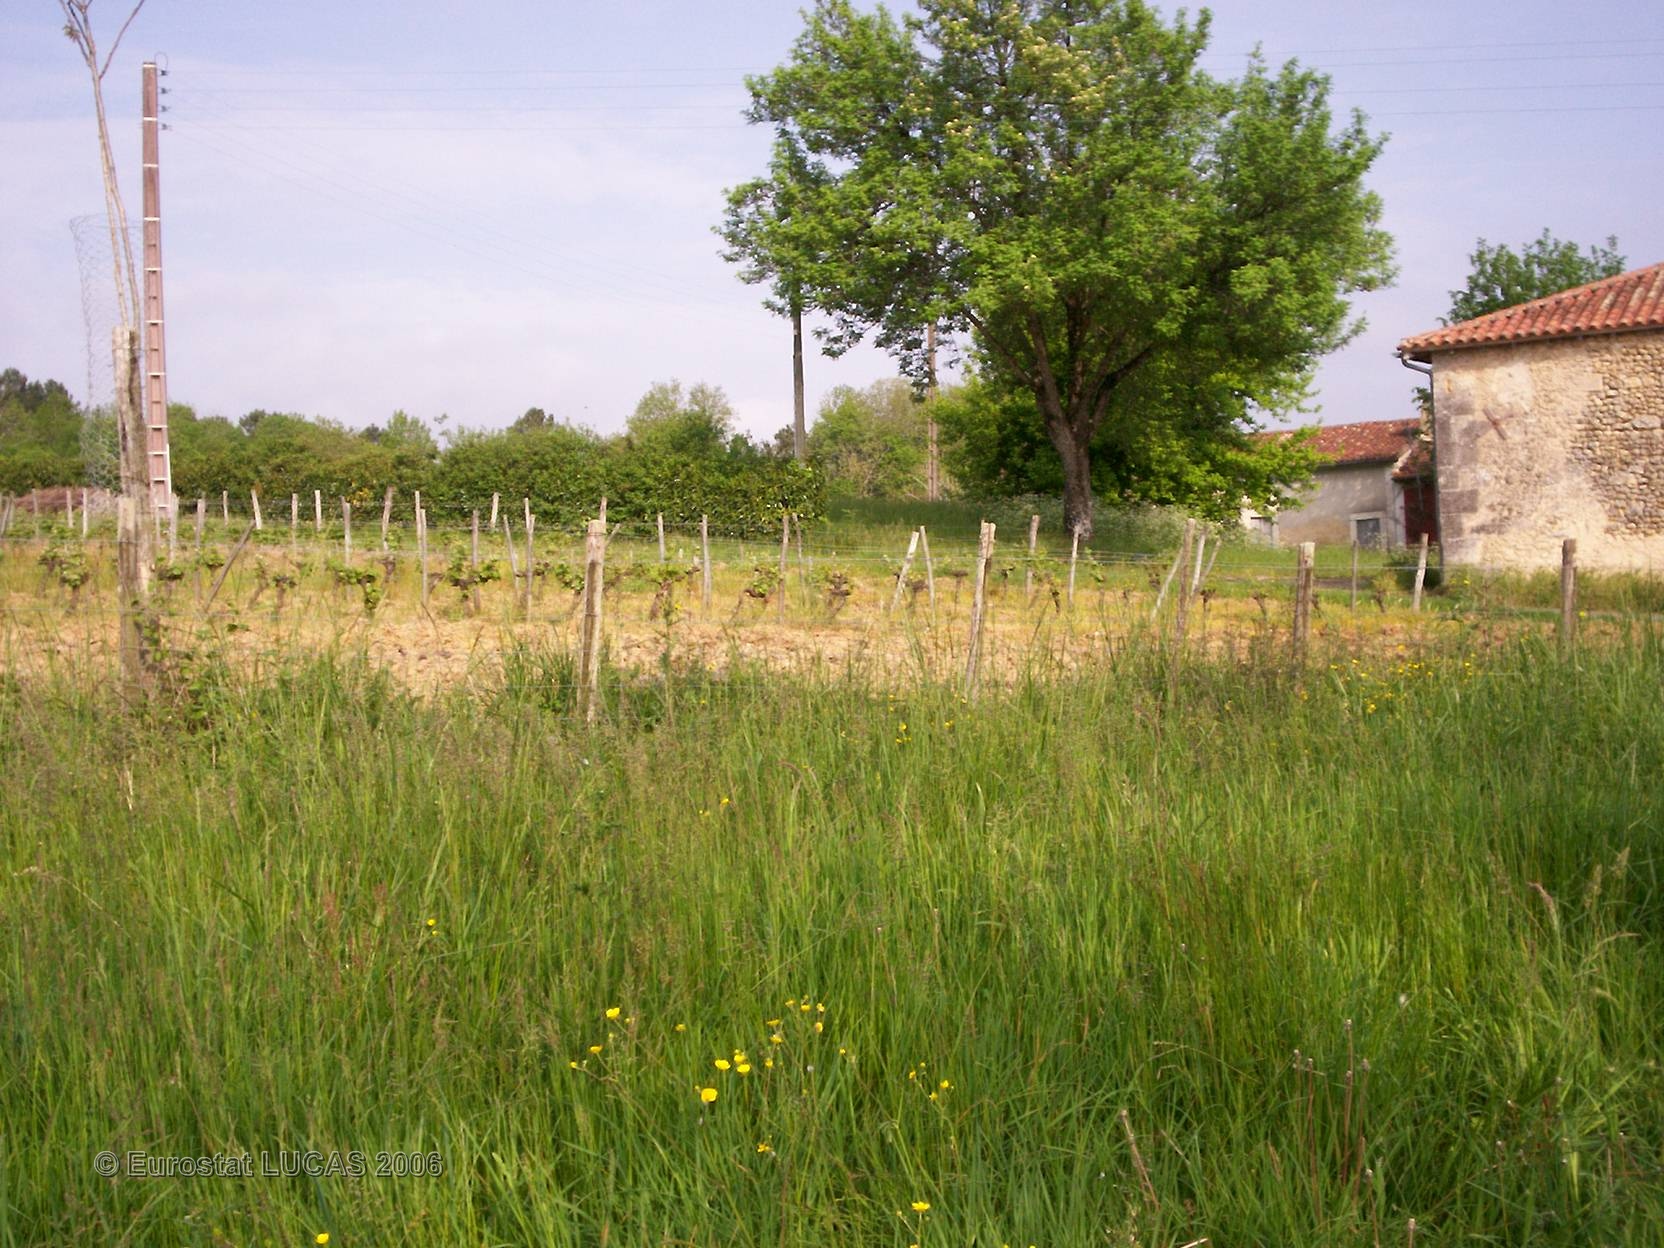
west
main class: Grassland
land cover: Grassland with sparse tree/shrub cover
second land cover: Nuts trees
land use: Agriculture (excluding fallow land and kitchen gardens)
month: May
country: FR
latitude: 45.2317
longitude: 0.8326
